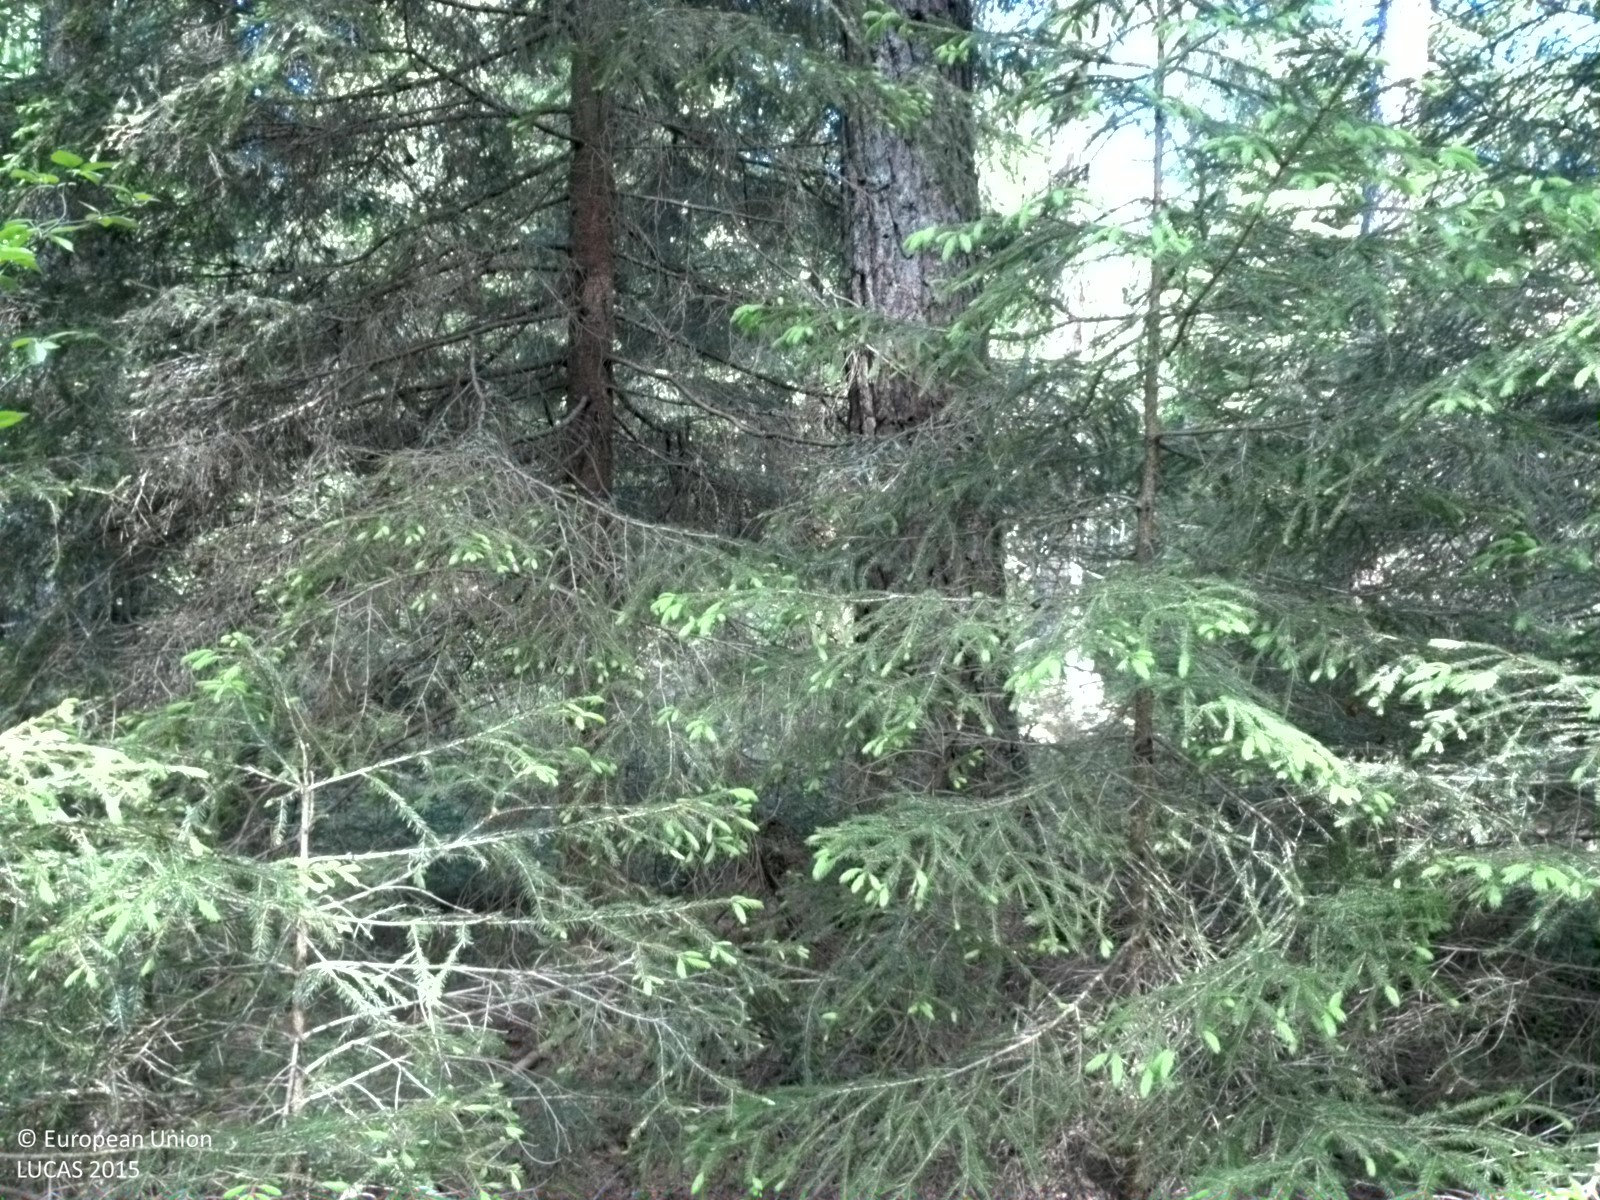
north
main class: Woodland
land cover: Spruce dominated coniferous woodland
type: boreal forest
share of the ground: > 75 %
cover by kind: coniferous forest trees 70 %, shrubs 10 %, lichens and mosses 10 %, broadleaved forest trees 5 %, herbaceous plants 5 %
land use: Forestry
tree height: > 5 m
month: June
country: SE
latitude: 60.3197
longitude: 17.2511
